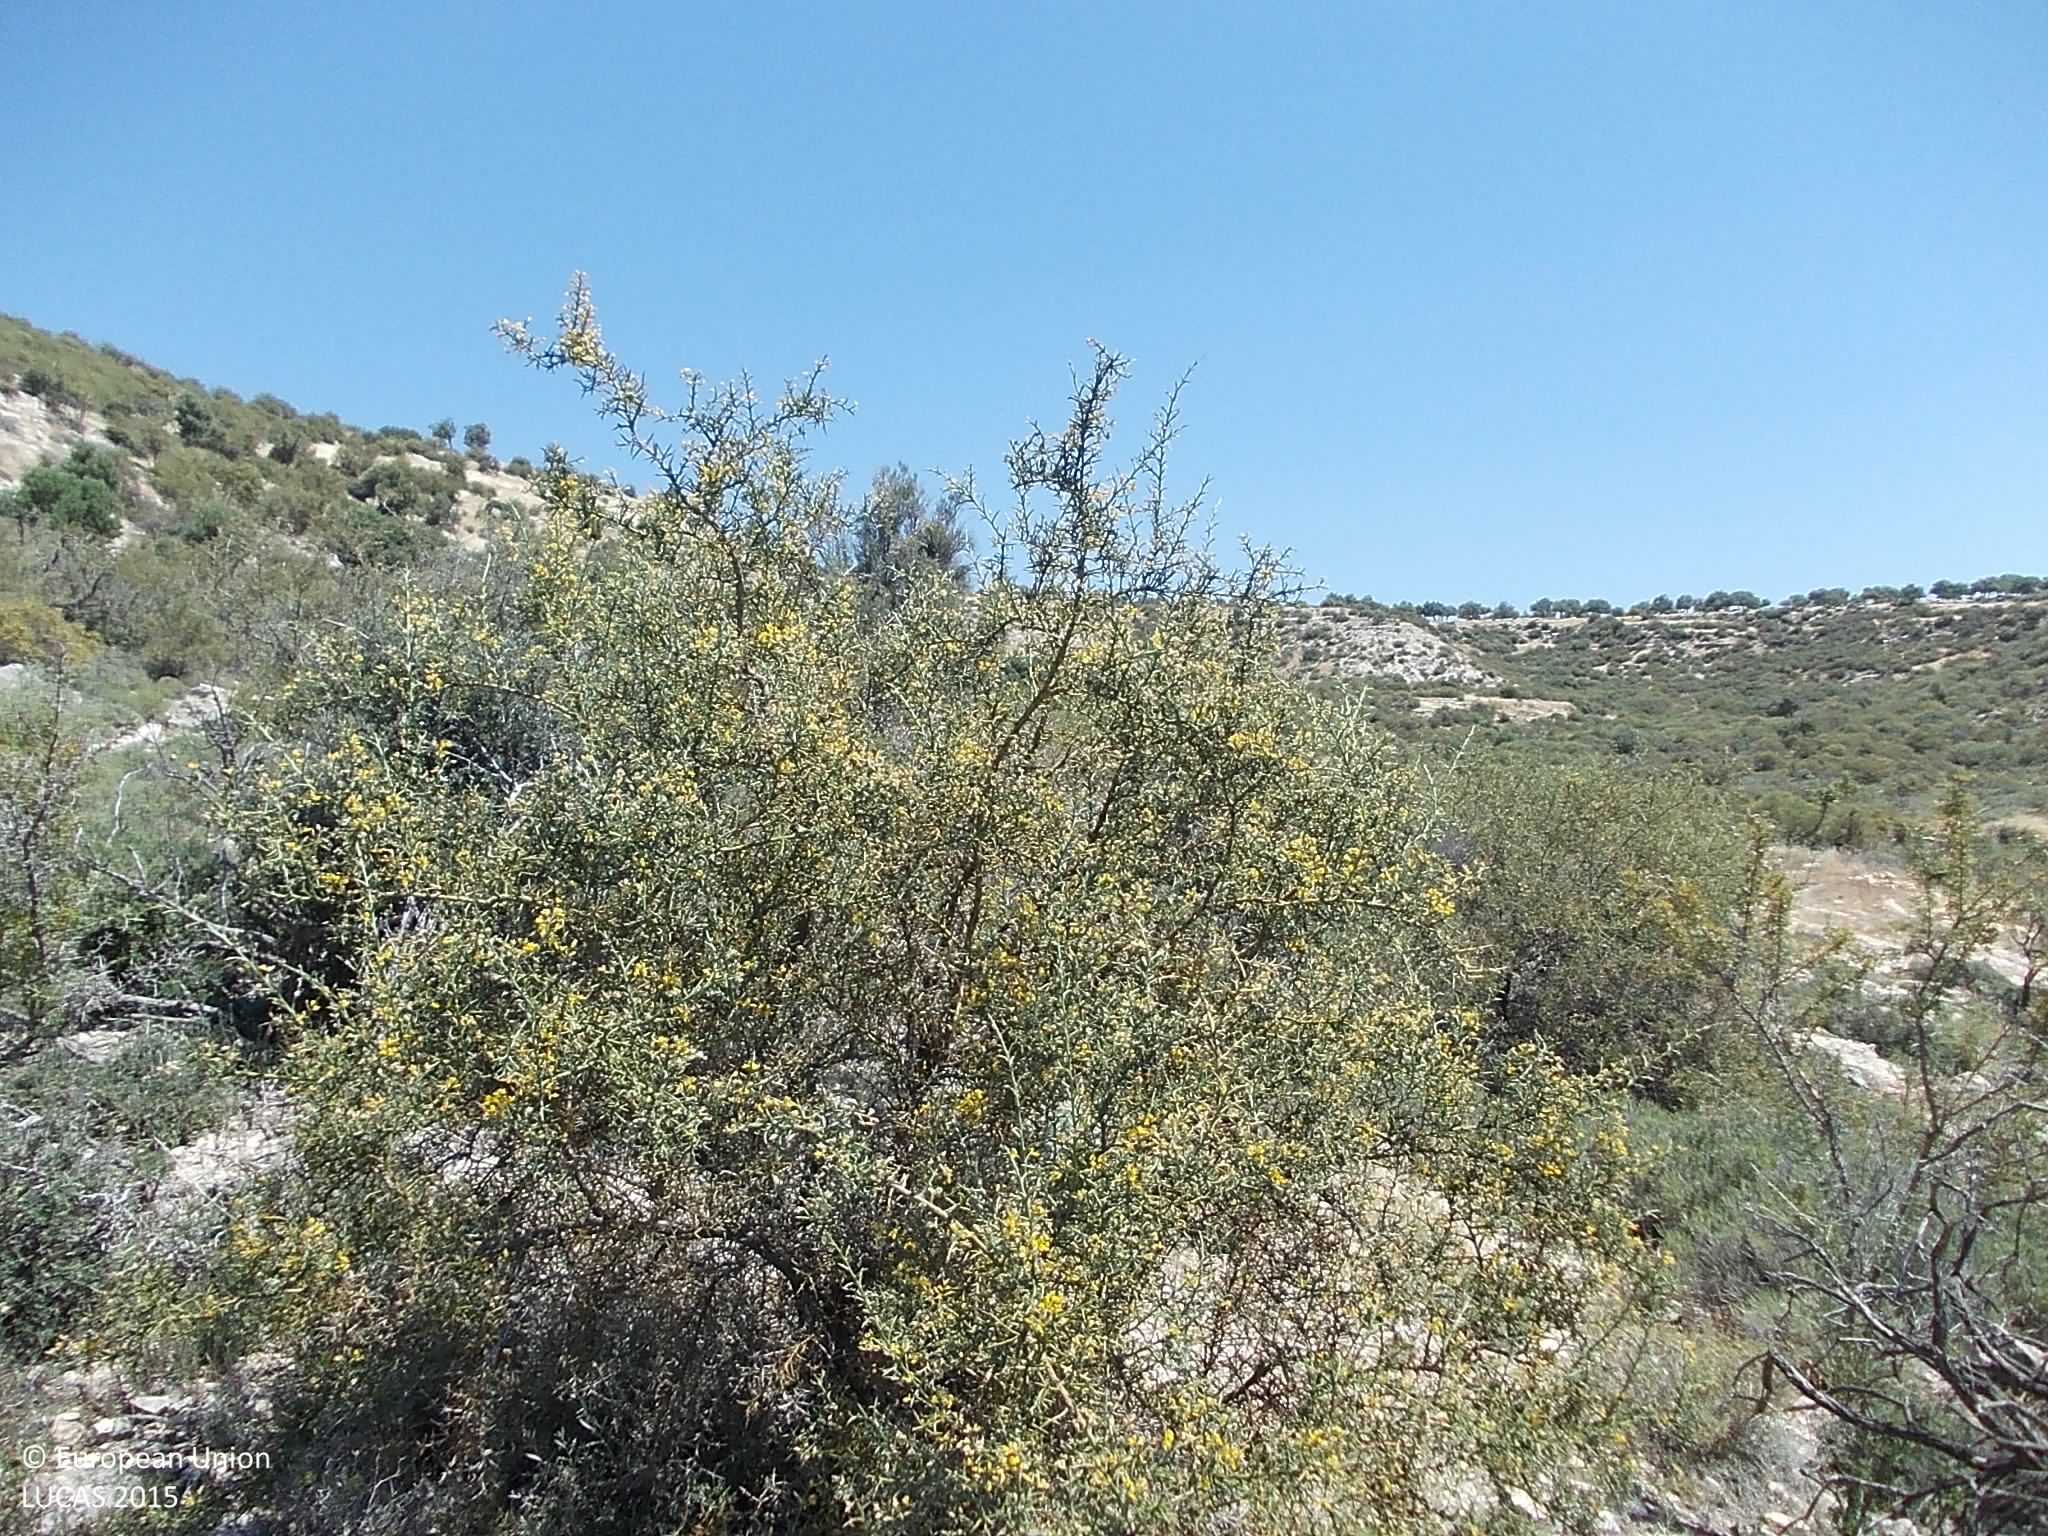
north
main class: Shrubland
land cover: Shrubland without tree cover
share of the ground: > 75 %
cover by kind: shrubs 80 %, unconsolidated bare surface 20 %
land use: Semi-natural and natural areas not in use
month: May
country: CY
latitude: 34.6984
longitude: 32.7862
